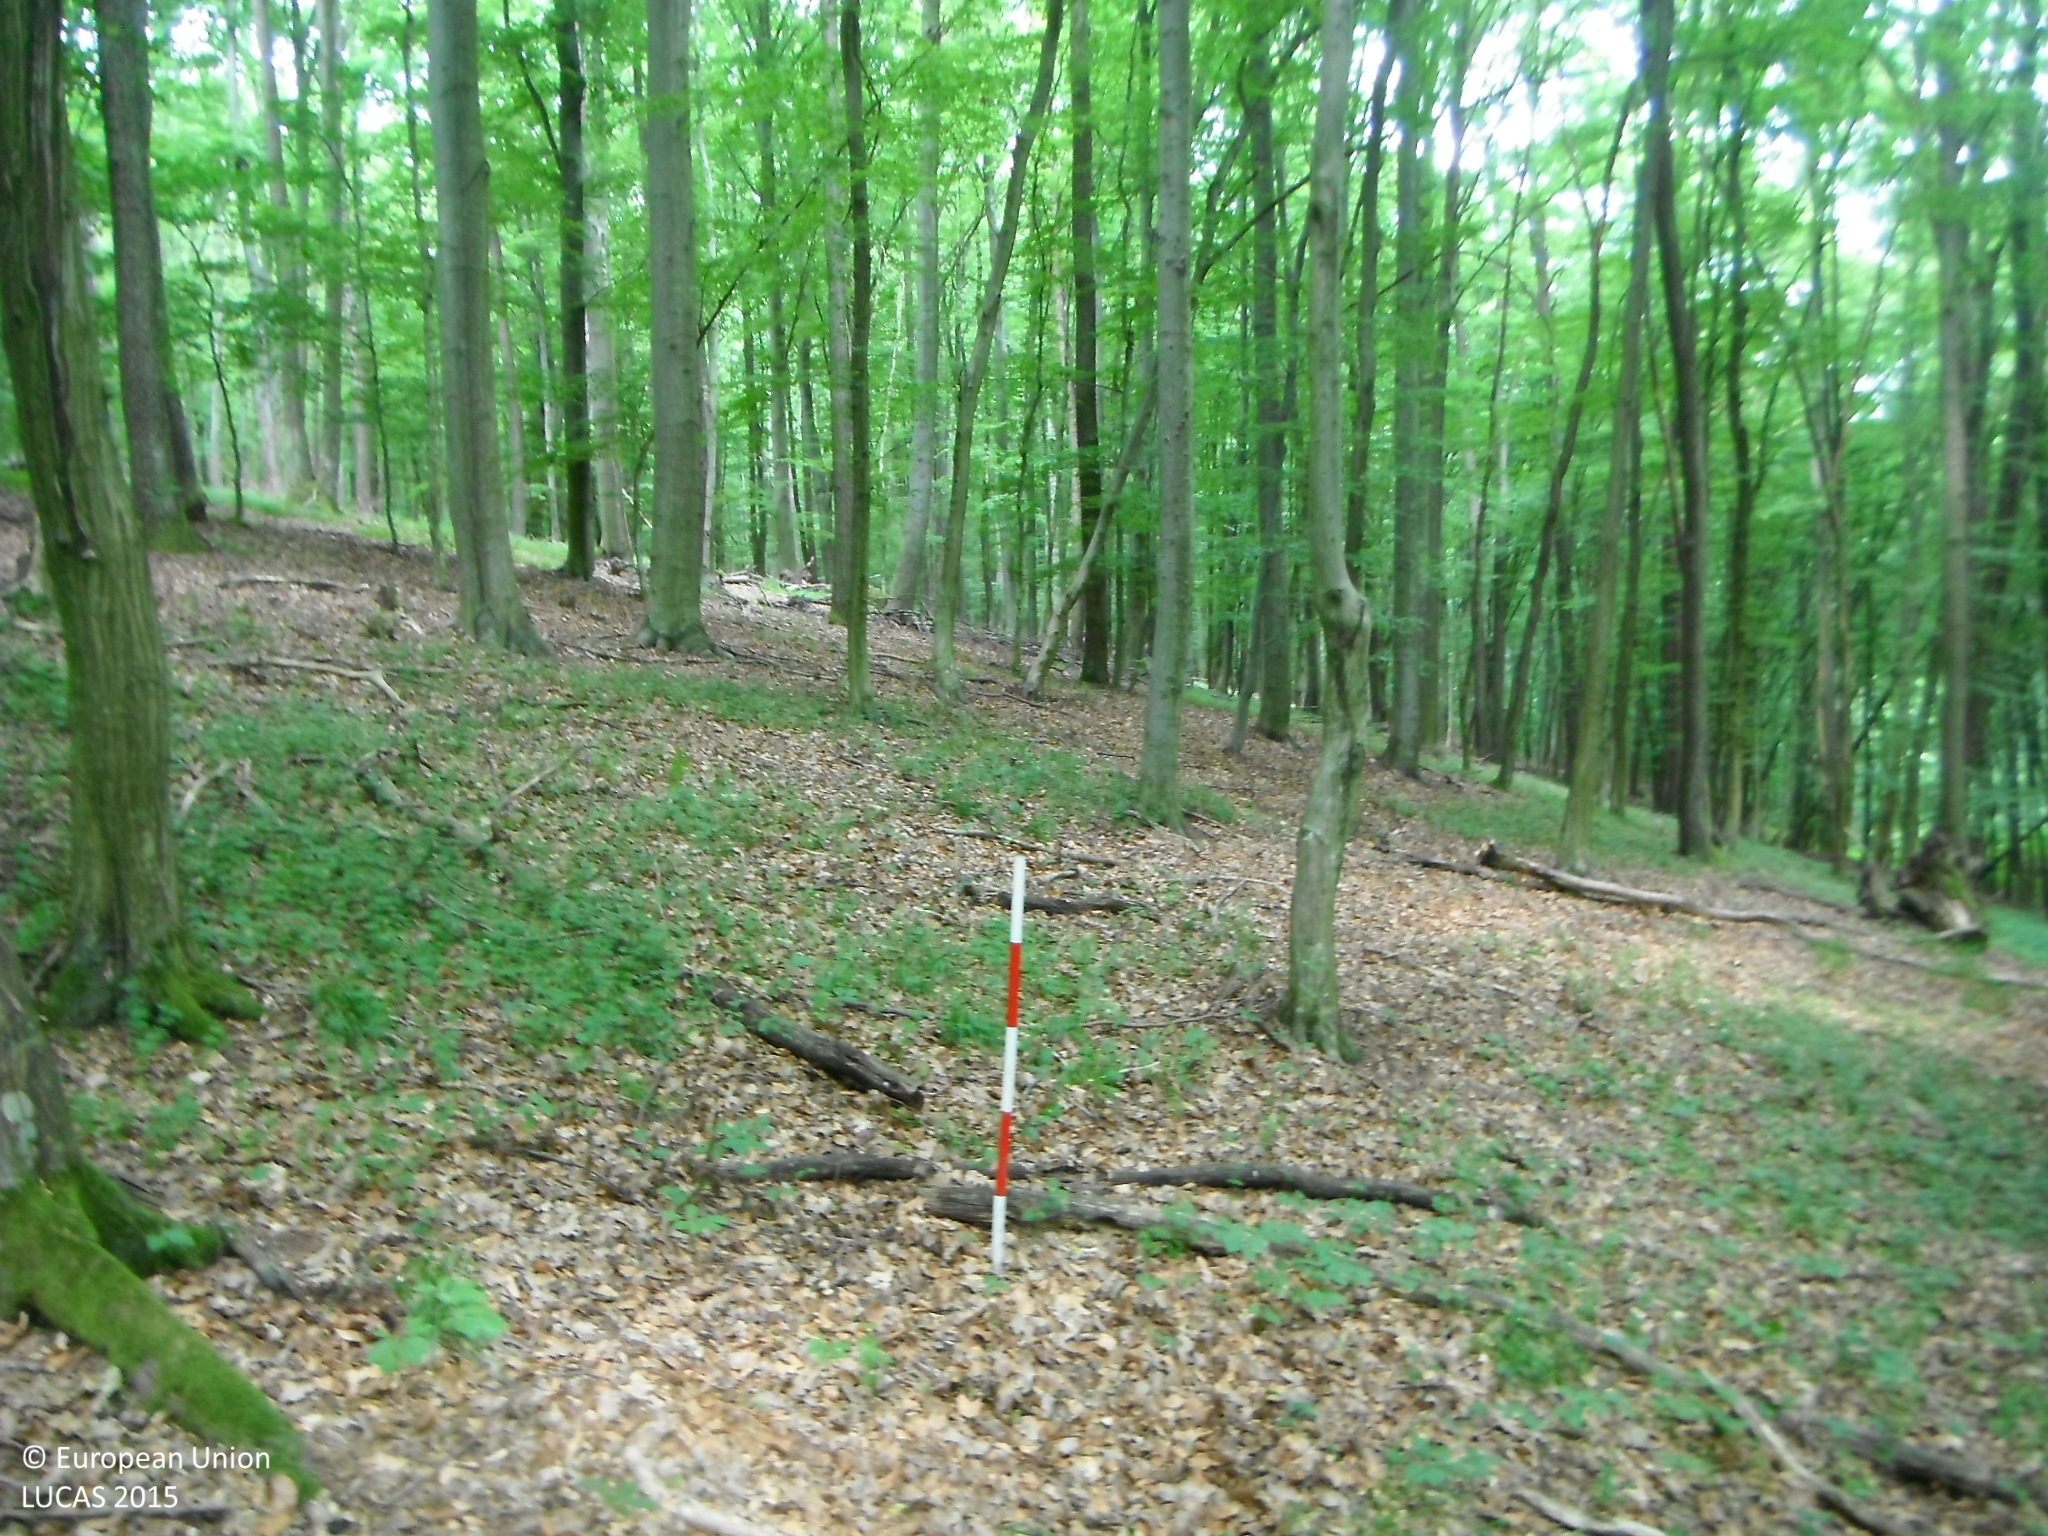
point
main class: Woodland
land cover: Broadleaved woodland
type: mesophytic deciduous forest
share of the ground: > 75 %
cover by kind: broadleaved forest trees 100 %
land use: Forestry
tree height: > 5 m
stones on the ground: < 10 %
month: June
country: SK
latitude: 48.4704
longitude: 18.3068
